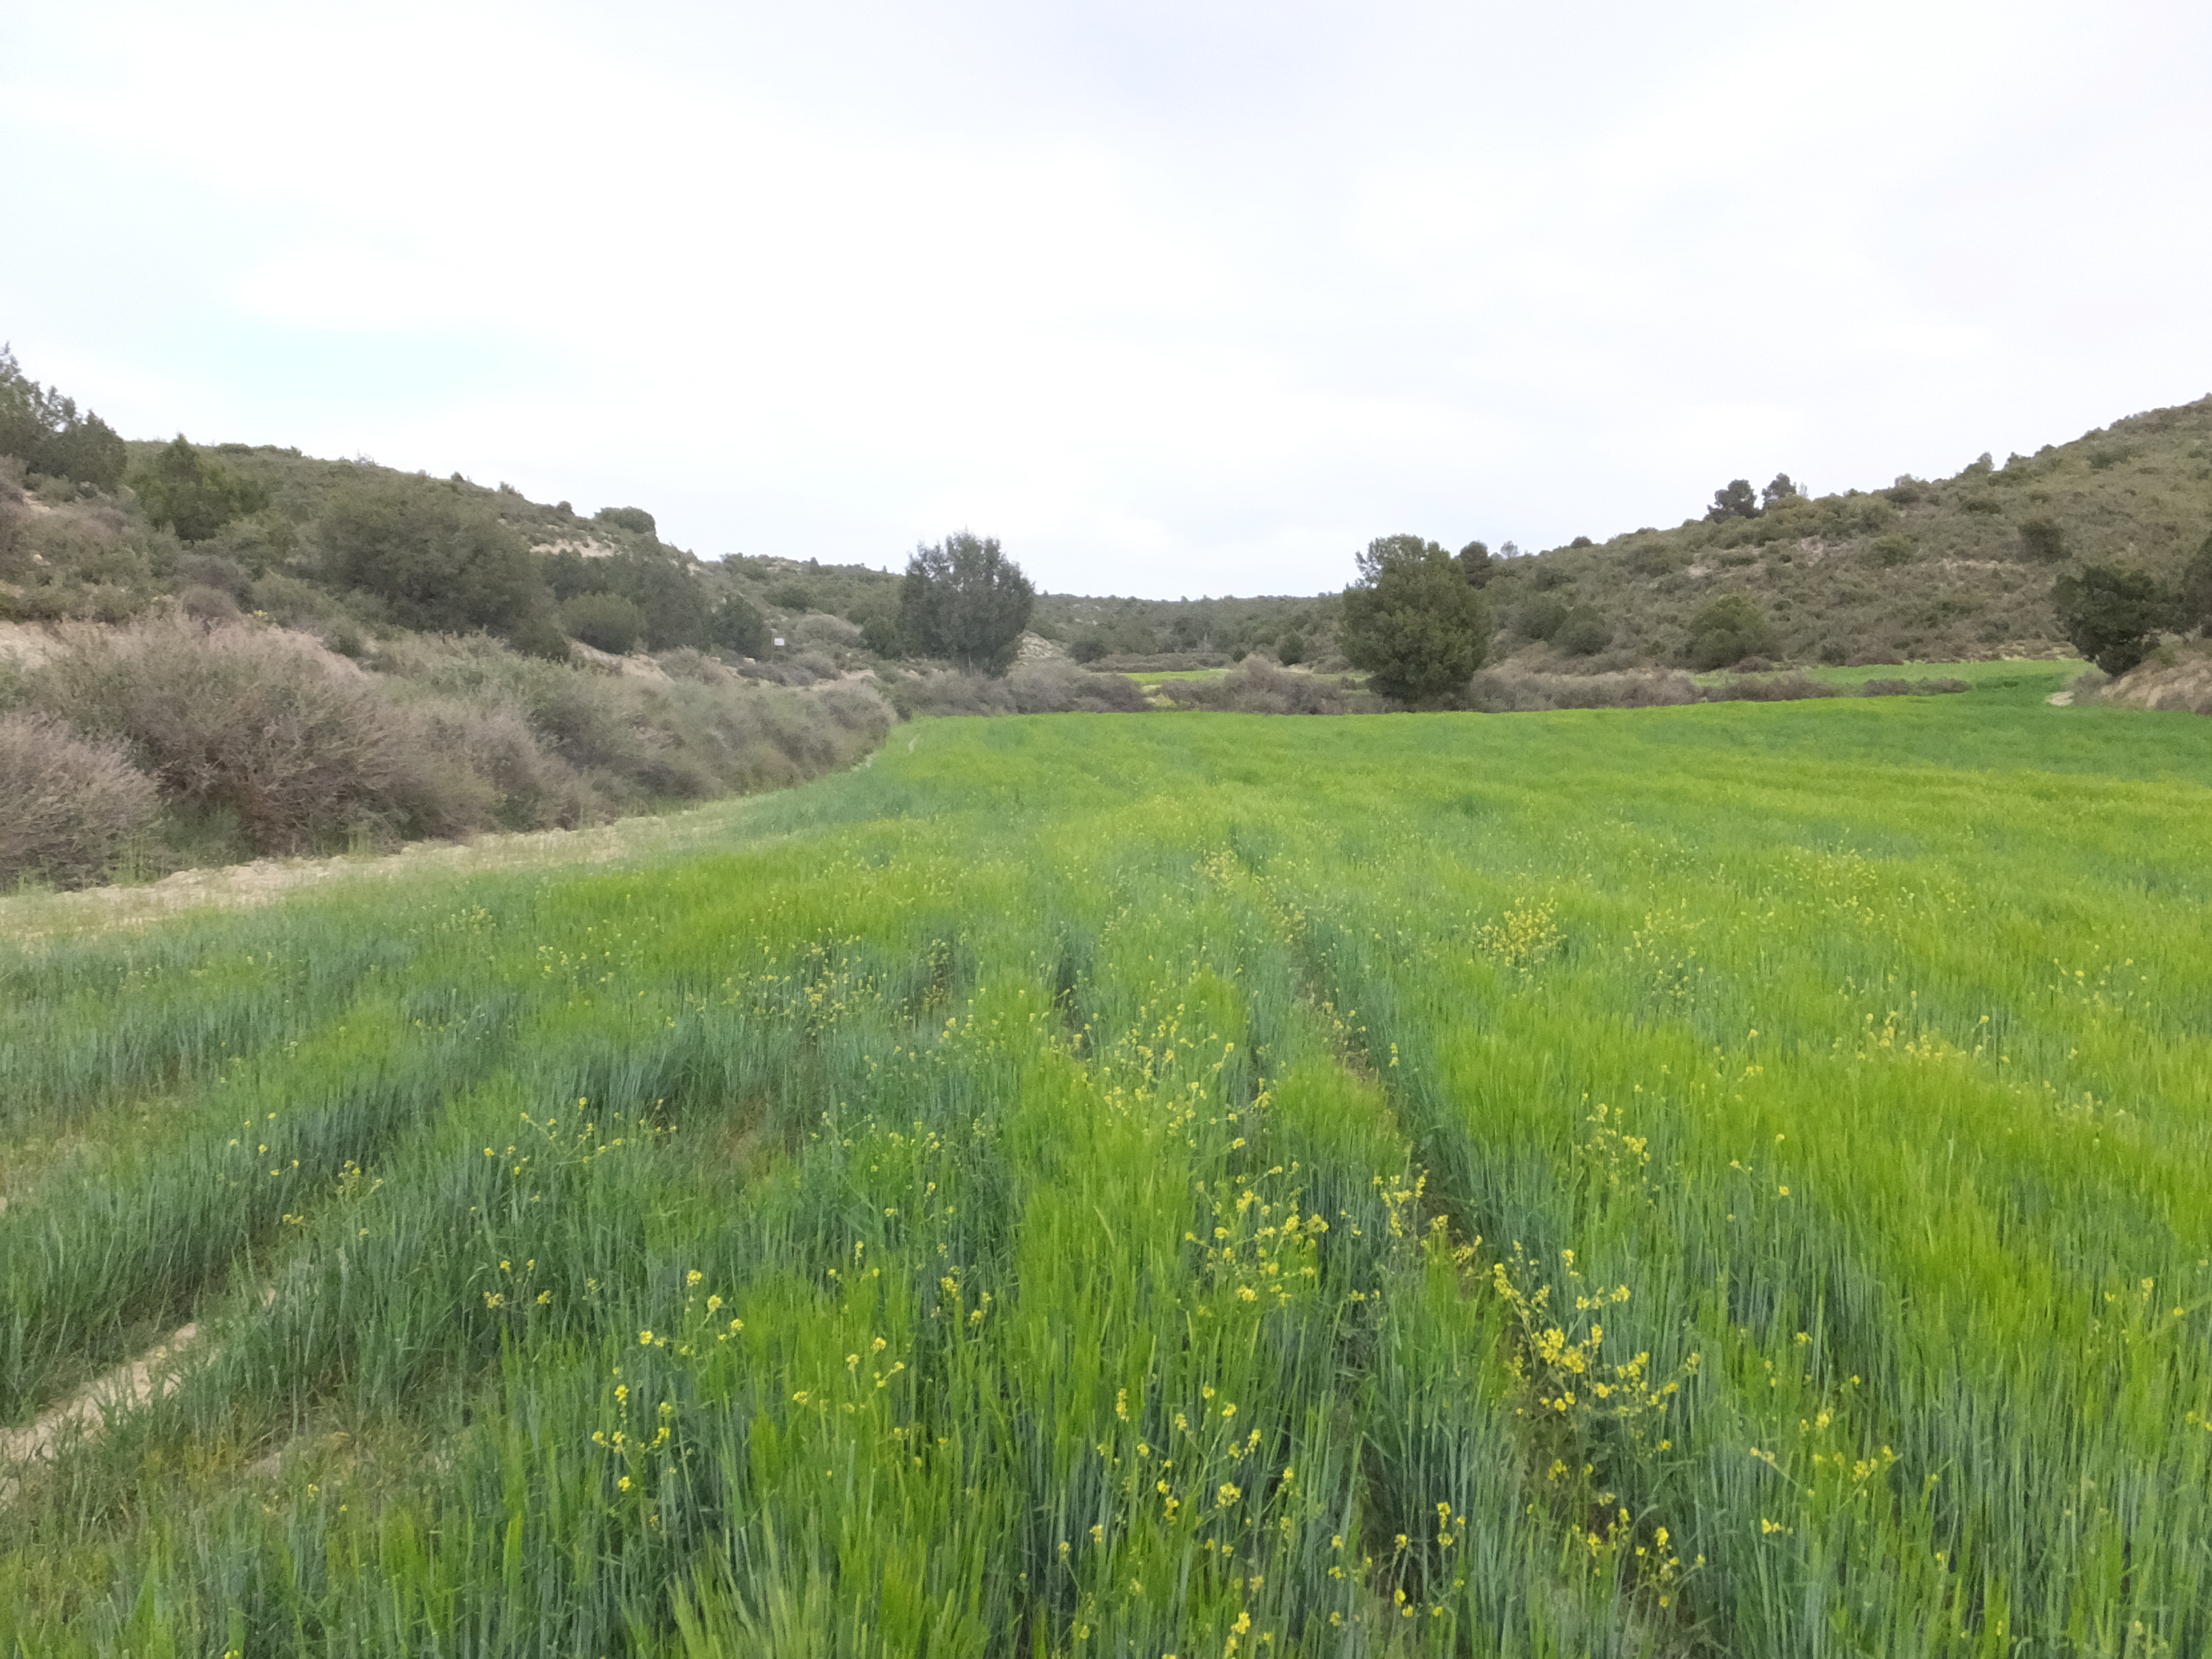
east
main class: Cropland
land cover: Barley
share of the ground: > 75 %
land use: Agriculture (excluding fallow land and kitchen gardens)
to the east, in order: Barley; Shruby margins; Dry stone walls; Single bushes/trees; Barley; Shruby margins; Barley; Shruby margins; Barley
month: April
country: ES
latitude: 41.6585
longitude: -0.2610
